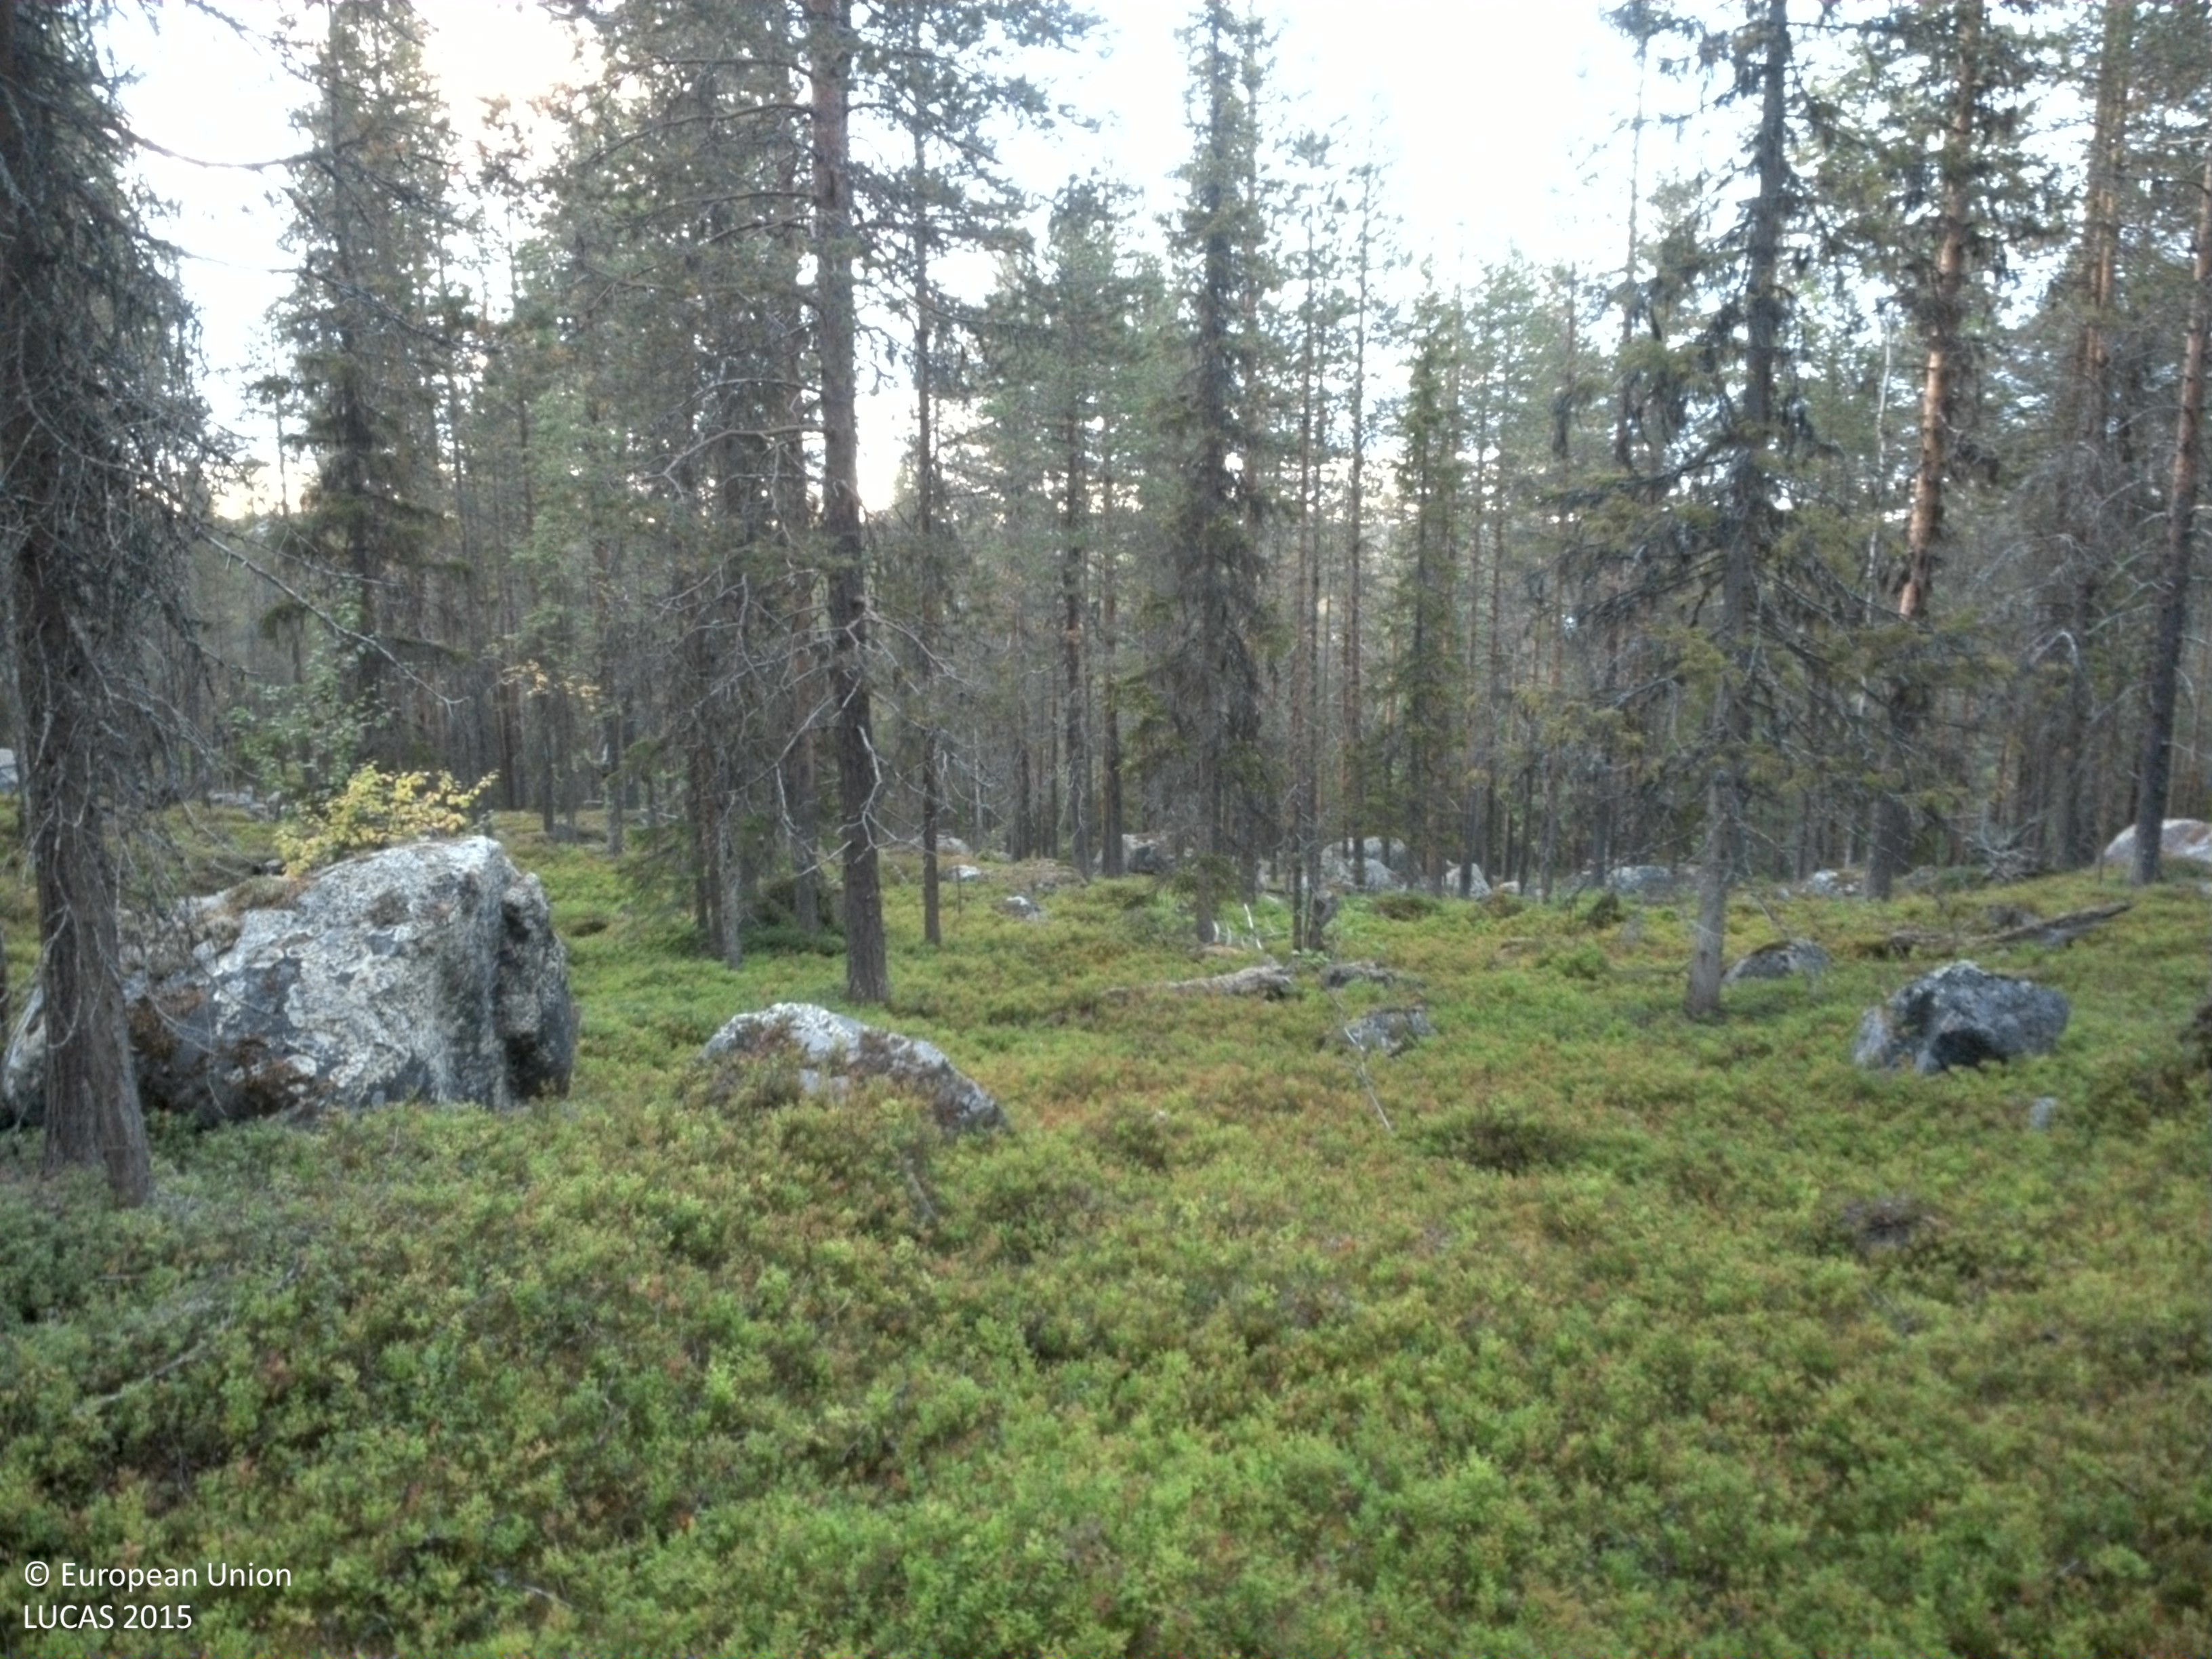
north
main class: Woodland
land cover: Pine dominated coniferous woodland
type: boreal forest
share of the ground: 10 - 25 %
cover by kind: shrubs 65 %, coniferous forest trees 20 %, lichens and mosses 10 %, consolidated bare surface 5 %
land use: Forestry
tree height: > 5 m
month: September
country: SE
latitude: 65.1613
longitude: 17.5791
